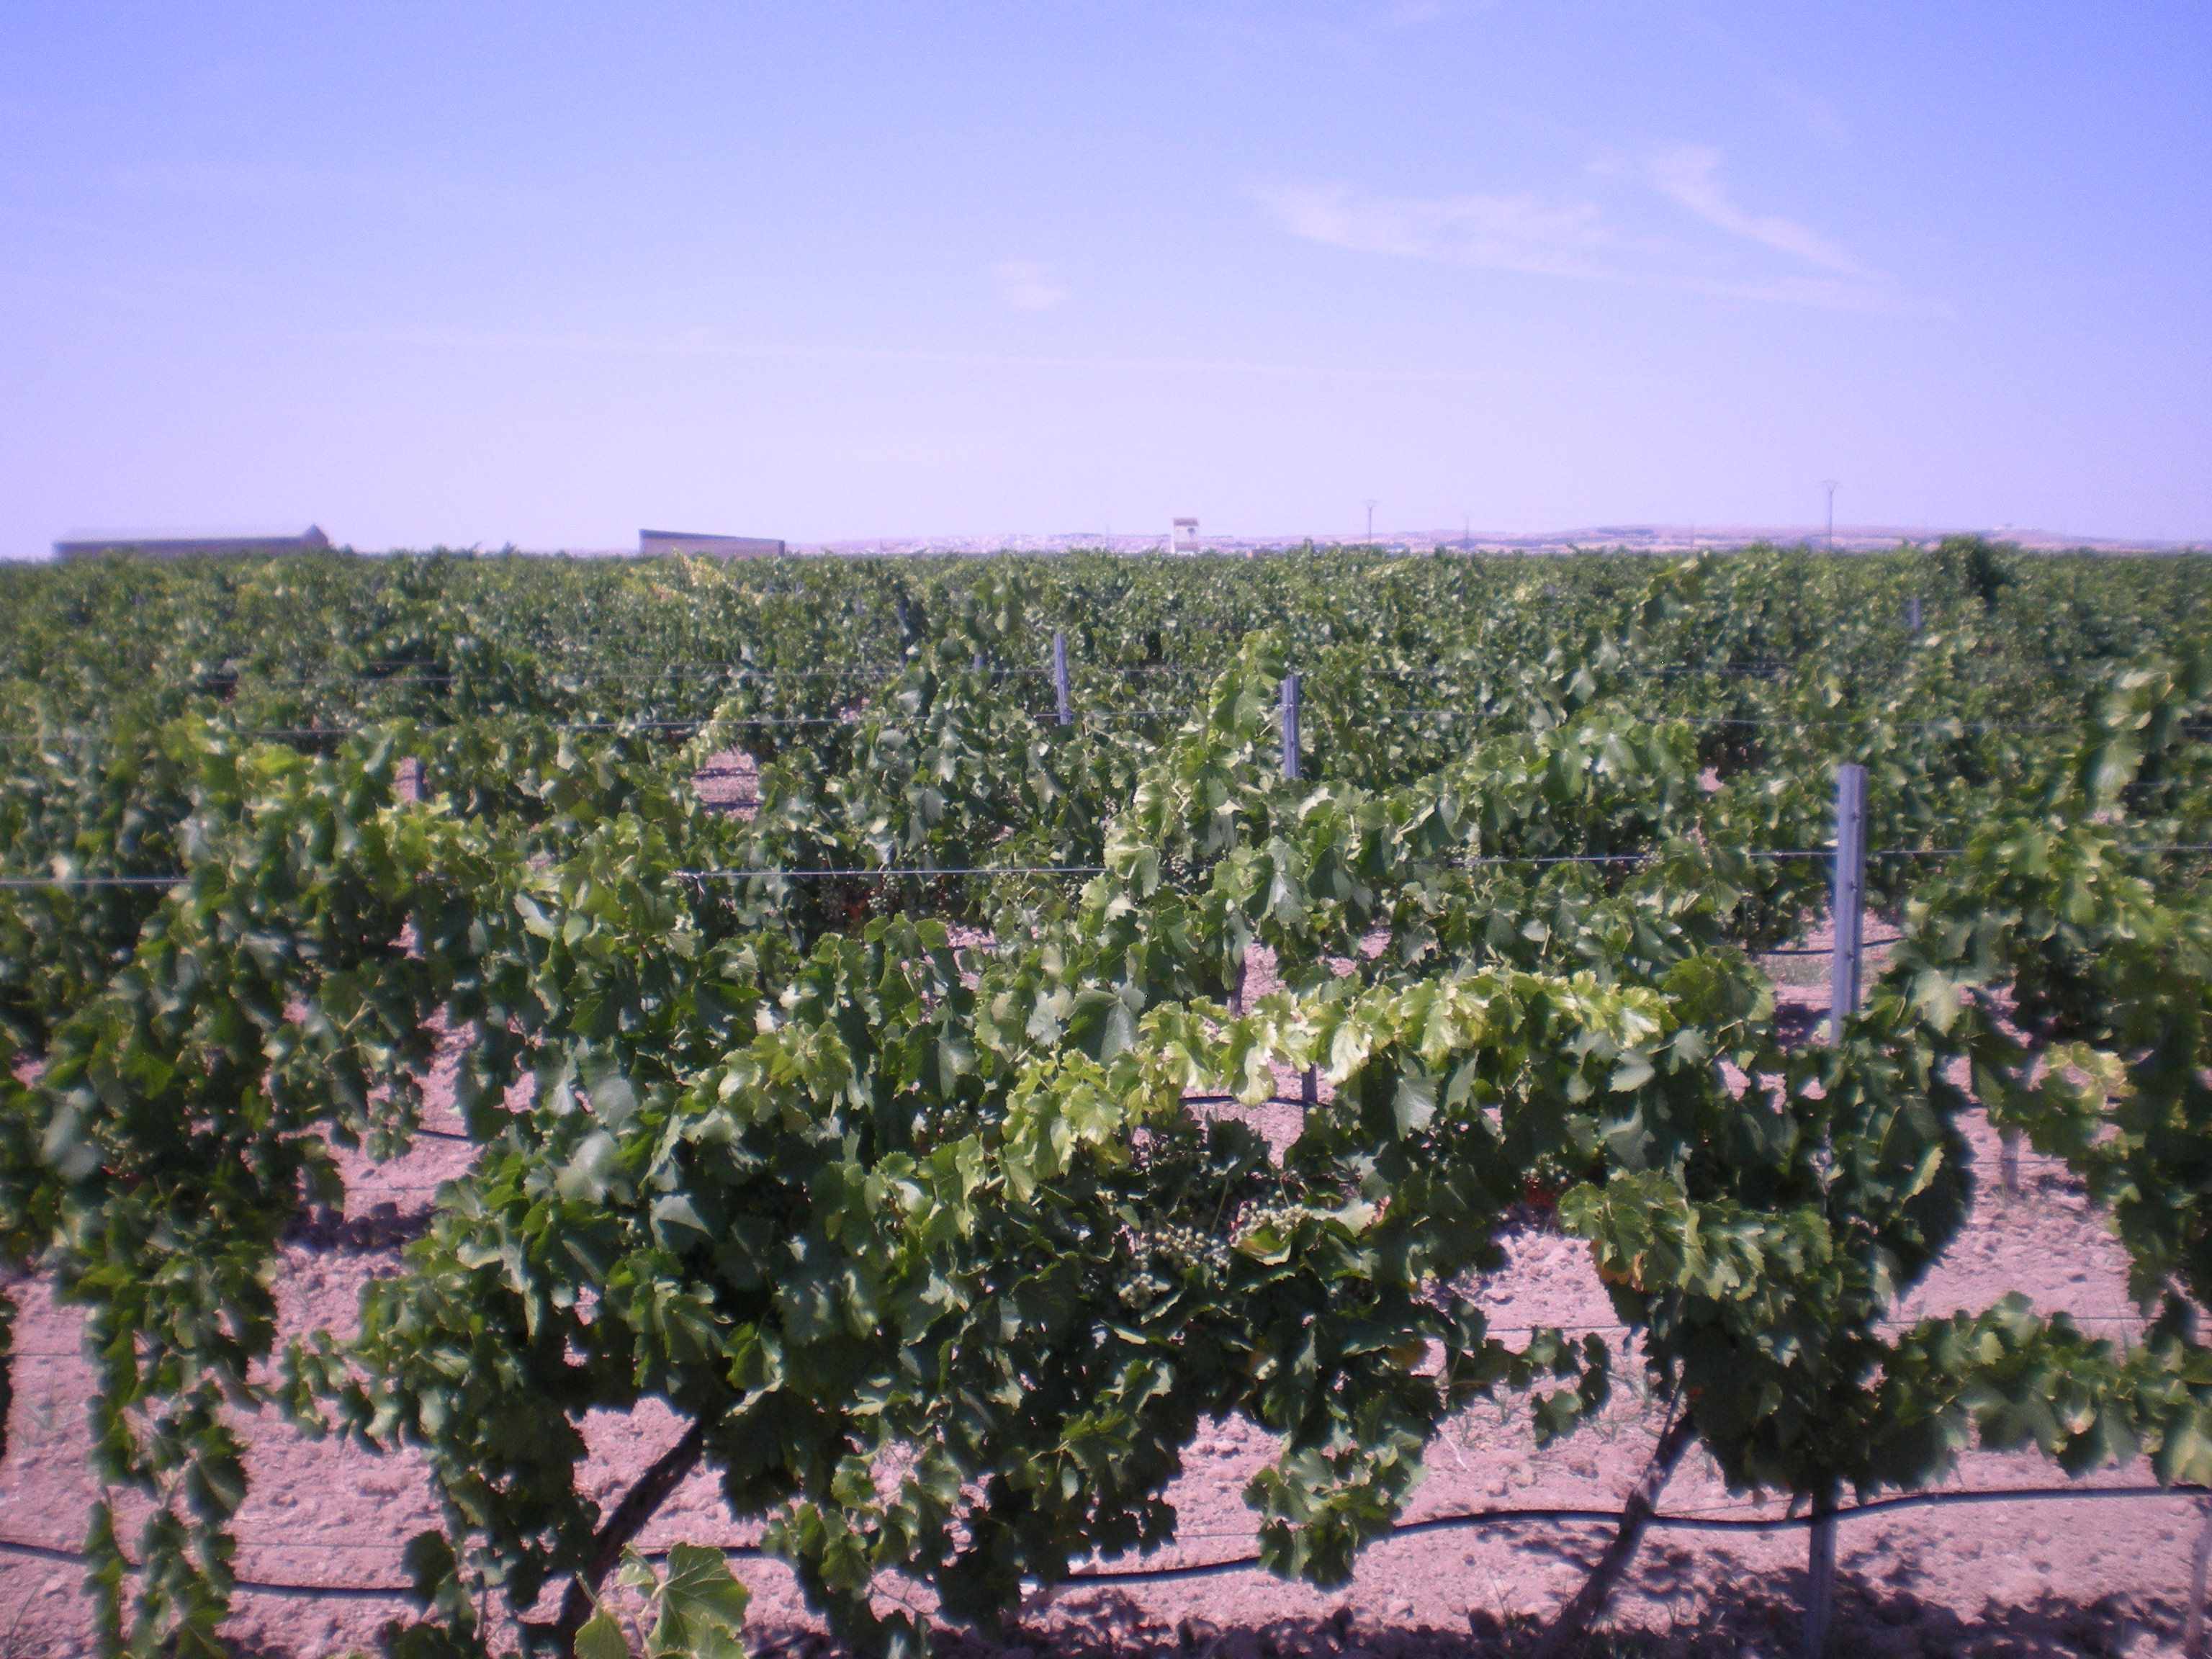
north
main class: Cropland
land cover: Vineyards
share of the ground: 25 - 50 %
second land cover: Spontaneously vegetated surfaces
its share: 10 - 25 %
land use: Agriculture (excluding fallow land and kitchen gardens)
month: July
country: ES
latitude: 39.3460
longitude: -3.1165
